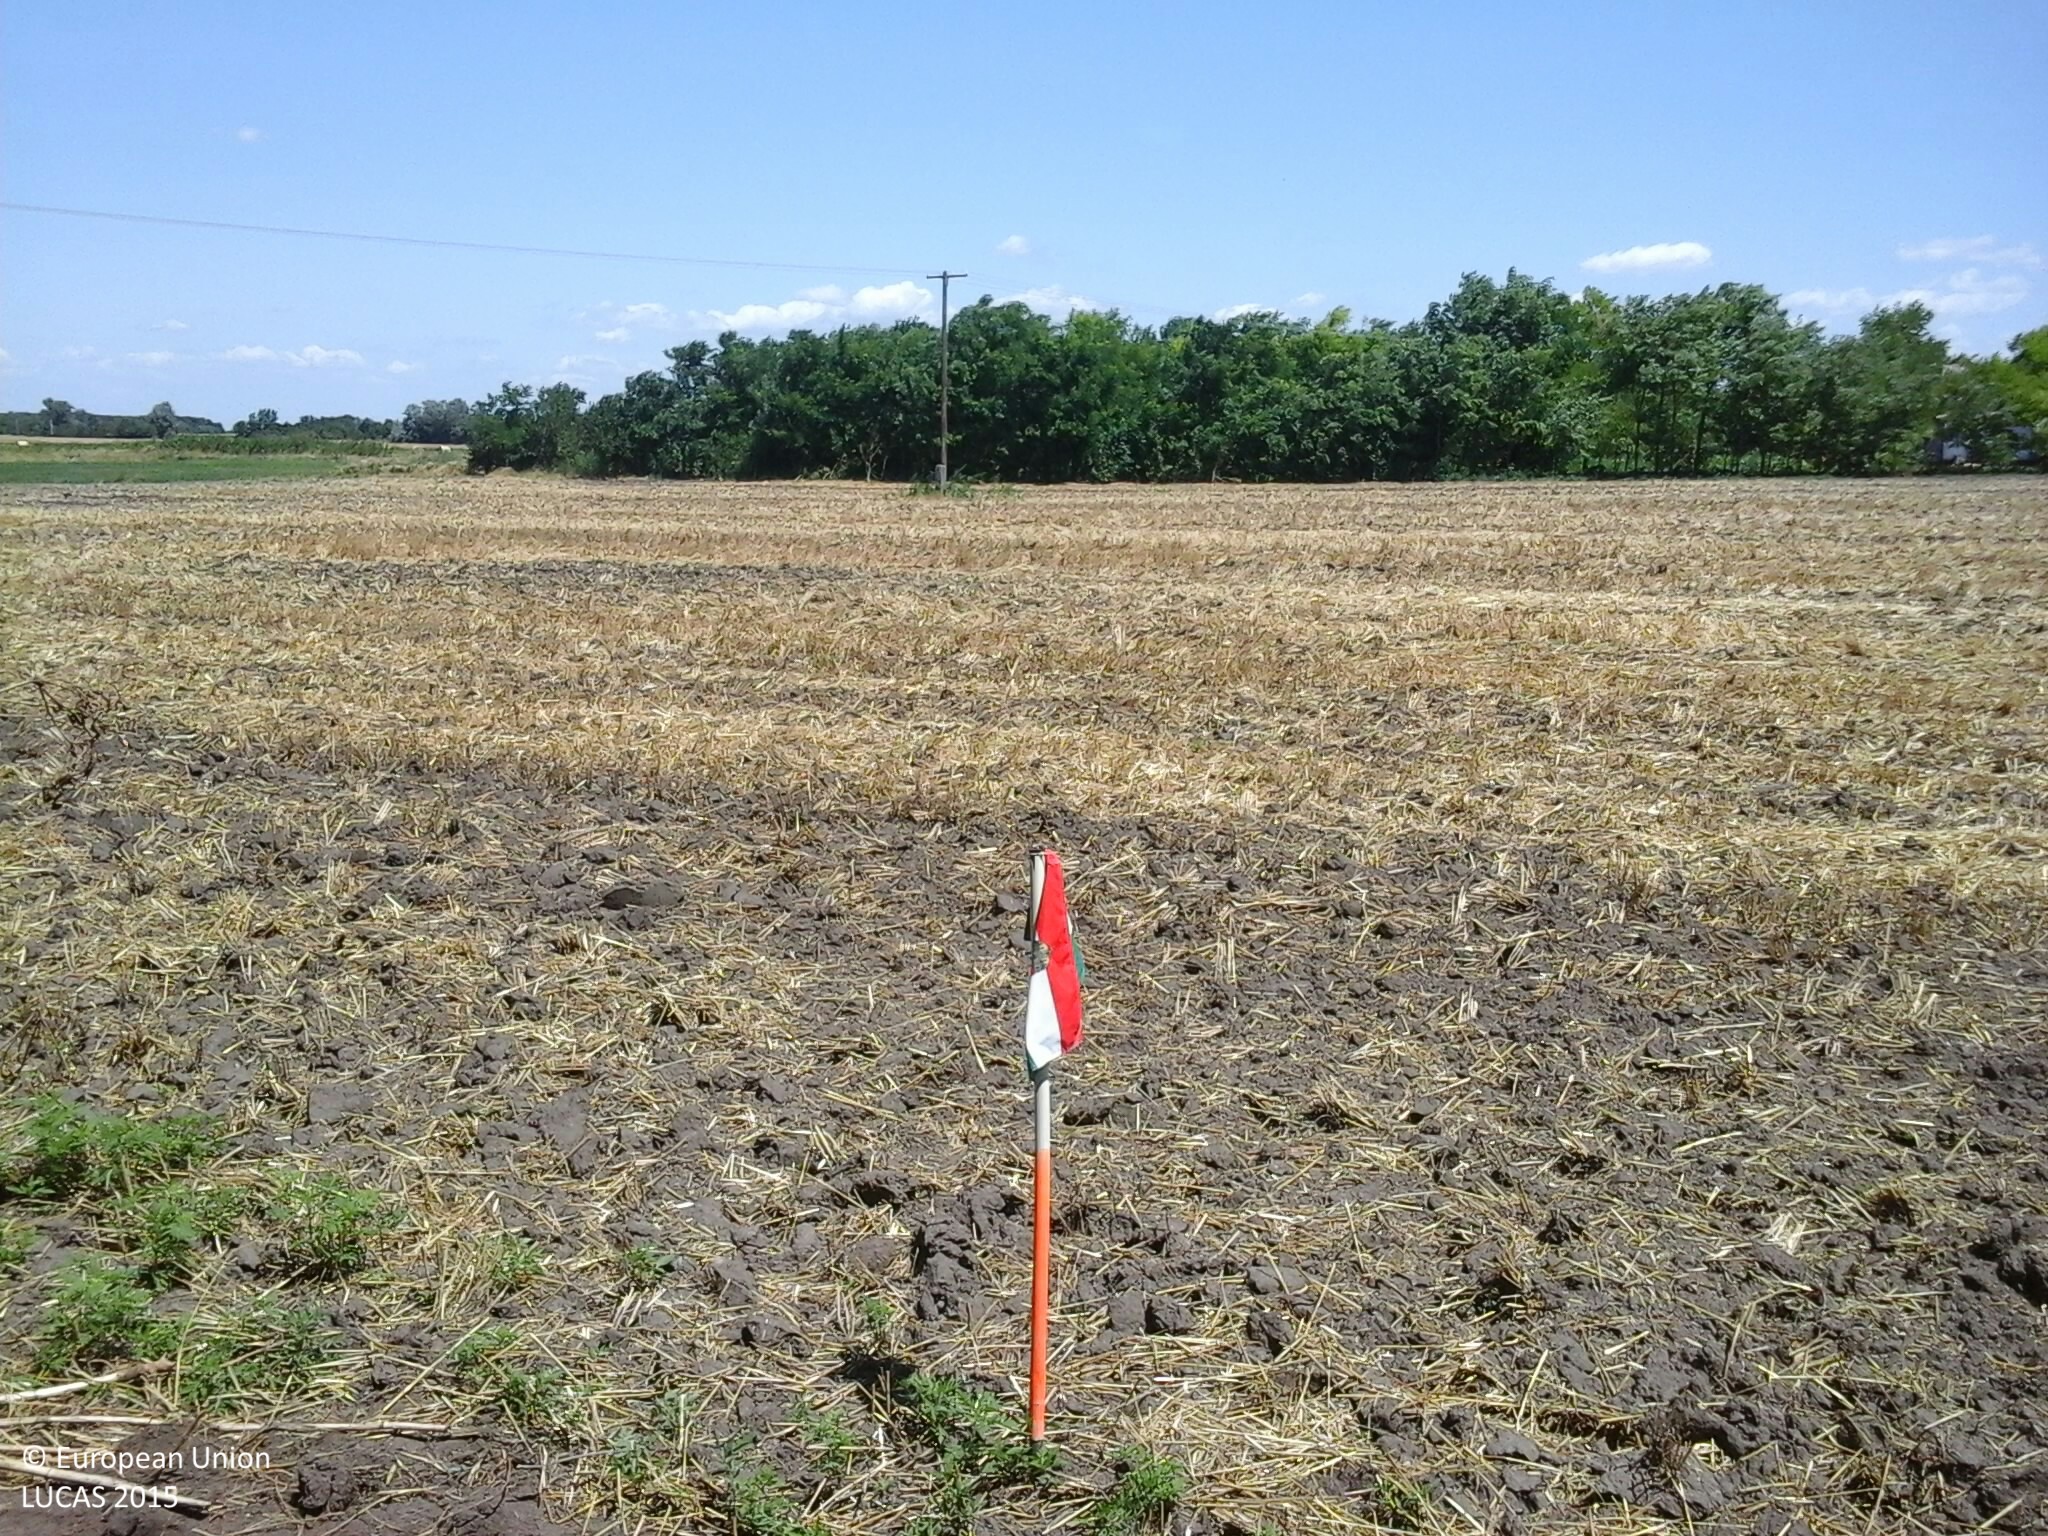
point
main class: Cropland
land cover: Common wheat
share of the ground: < 10 %
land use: Agriculture (excluding fallow land and kitchen gardens)
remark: Harvested field
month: July
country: HU
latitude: 46.6370
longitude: 20.0684
